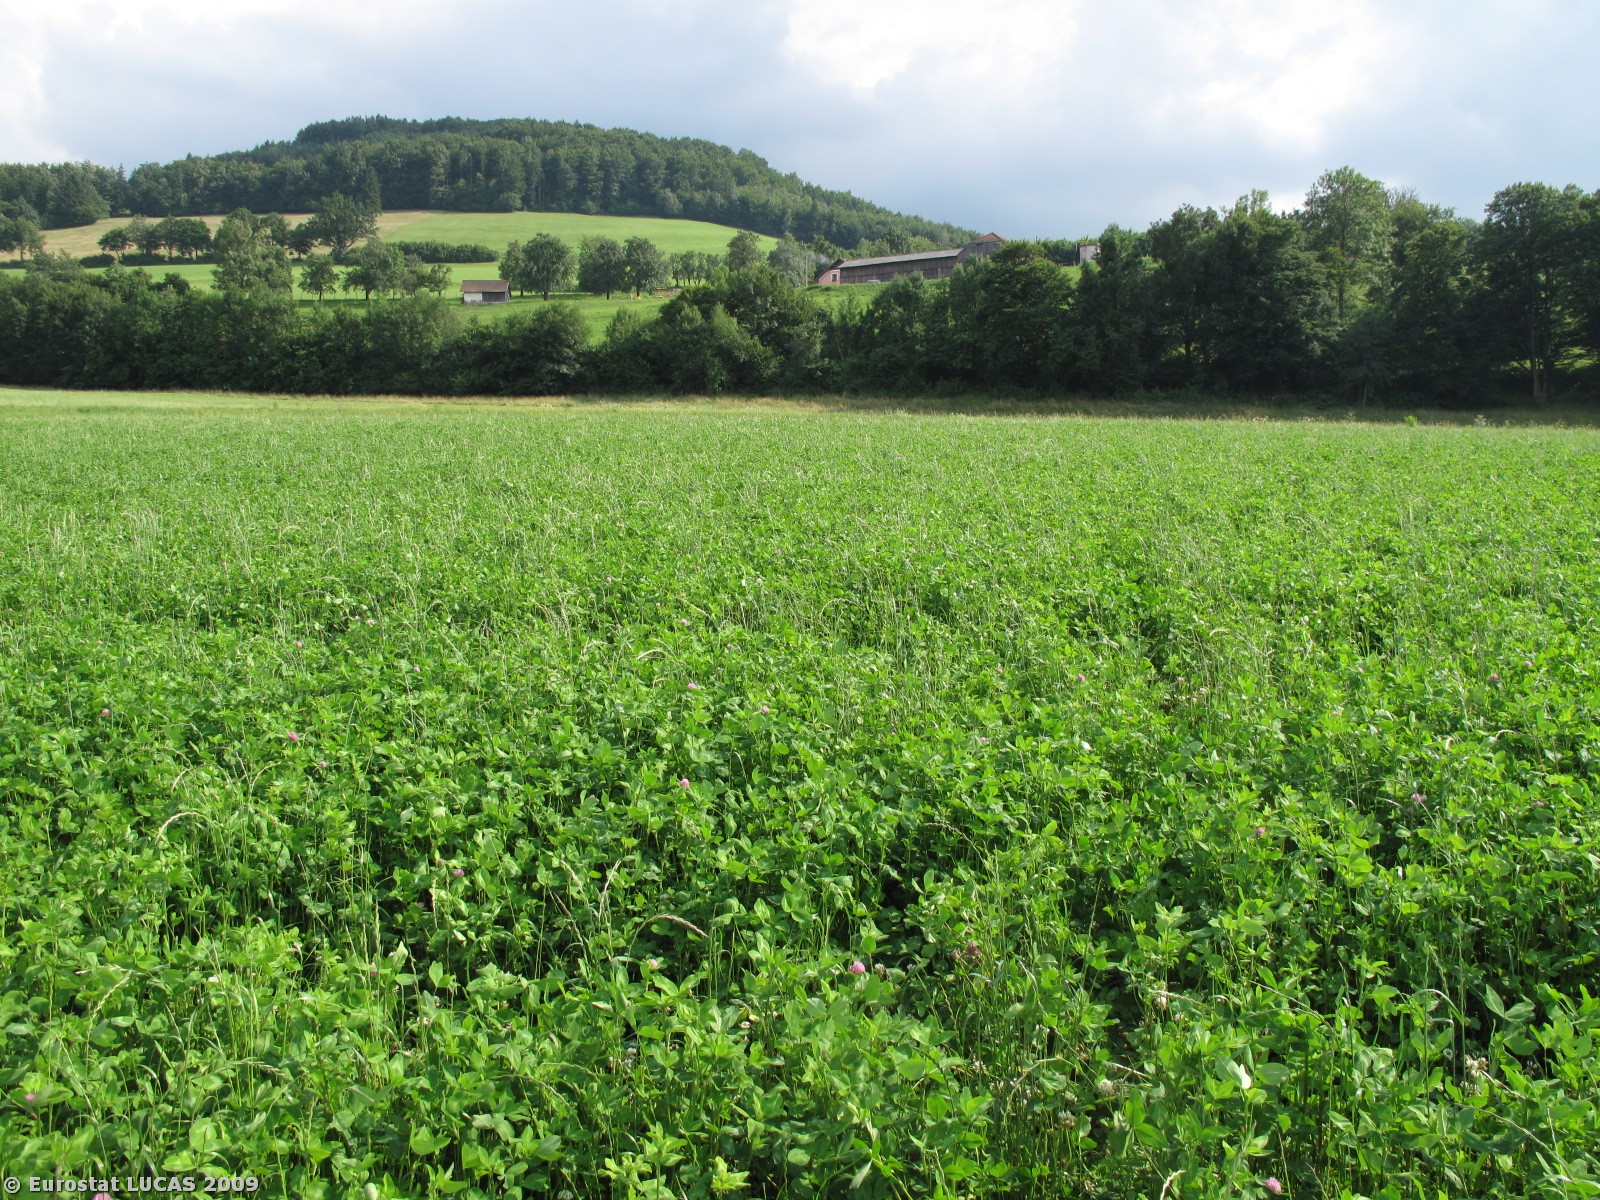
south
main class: Cropland
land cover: Clovers
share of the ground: > 75 %
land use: Agriculture (excluding fallow land and kitchen gardens)
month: July
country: AT
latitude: 48.0426
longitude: 15.6495
